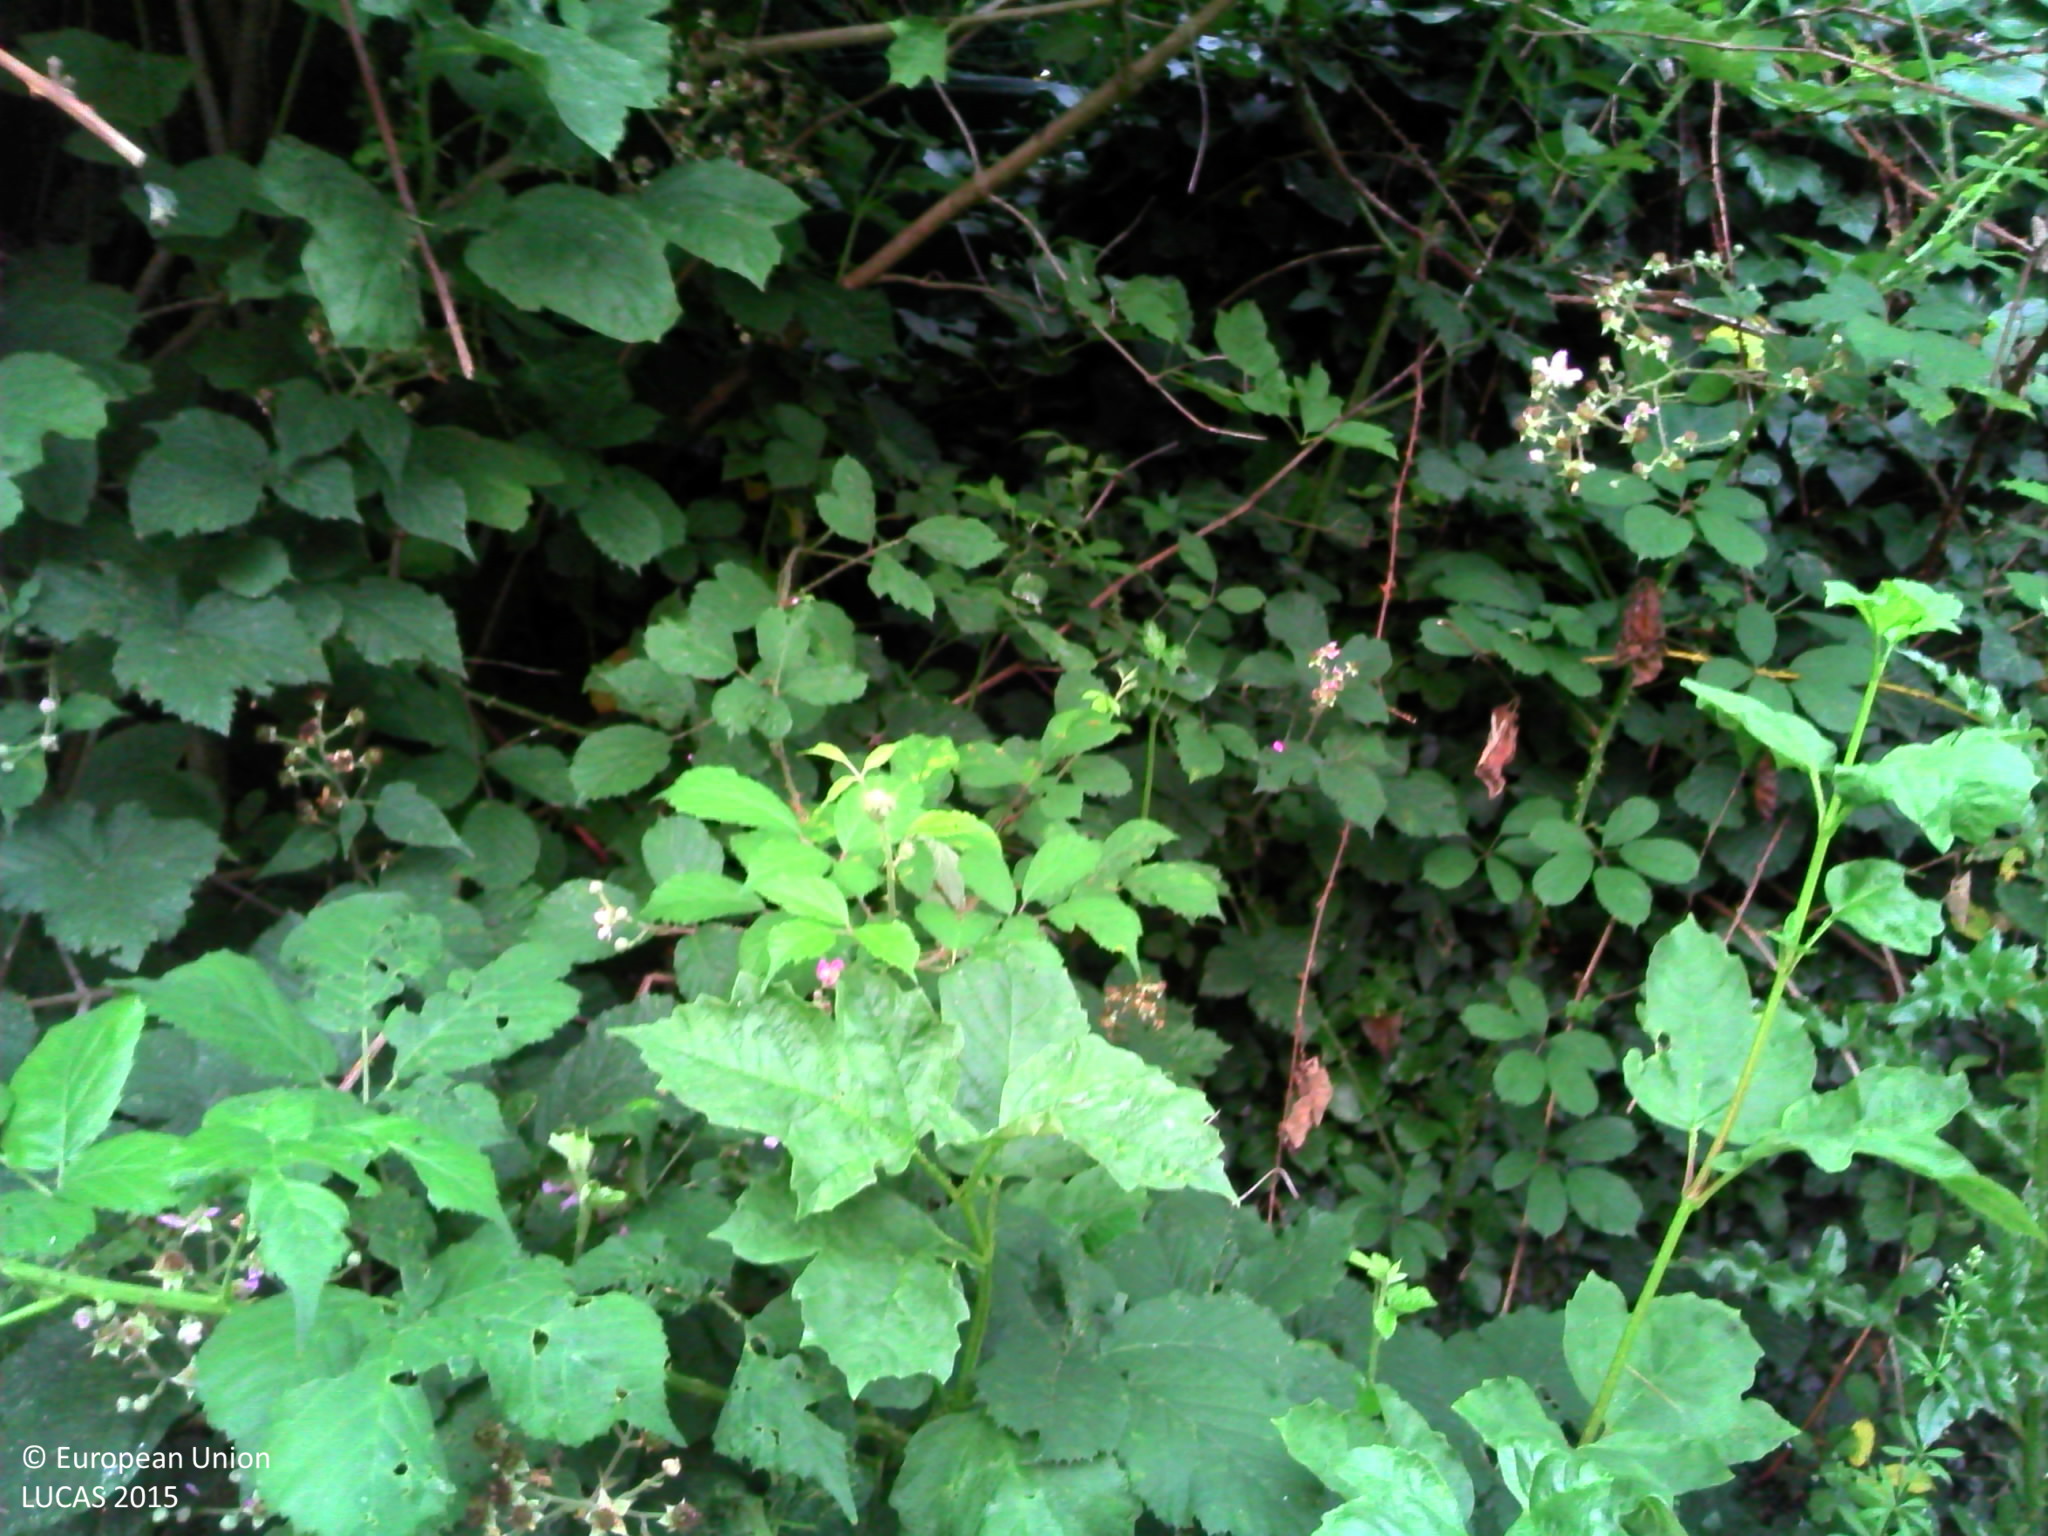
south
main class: Woodland
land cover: Broadleaved woodland
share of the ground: > 75 %
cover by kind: broadleaved forest trees 50 %, shrubs 25 %, herbaceous plants 25 %
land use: Abandoned areas
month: July
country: FR
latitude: 48.3438
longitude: -1.1734
